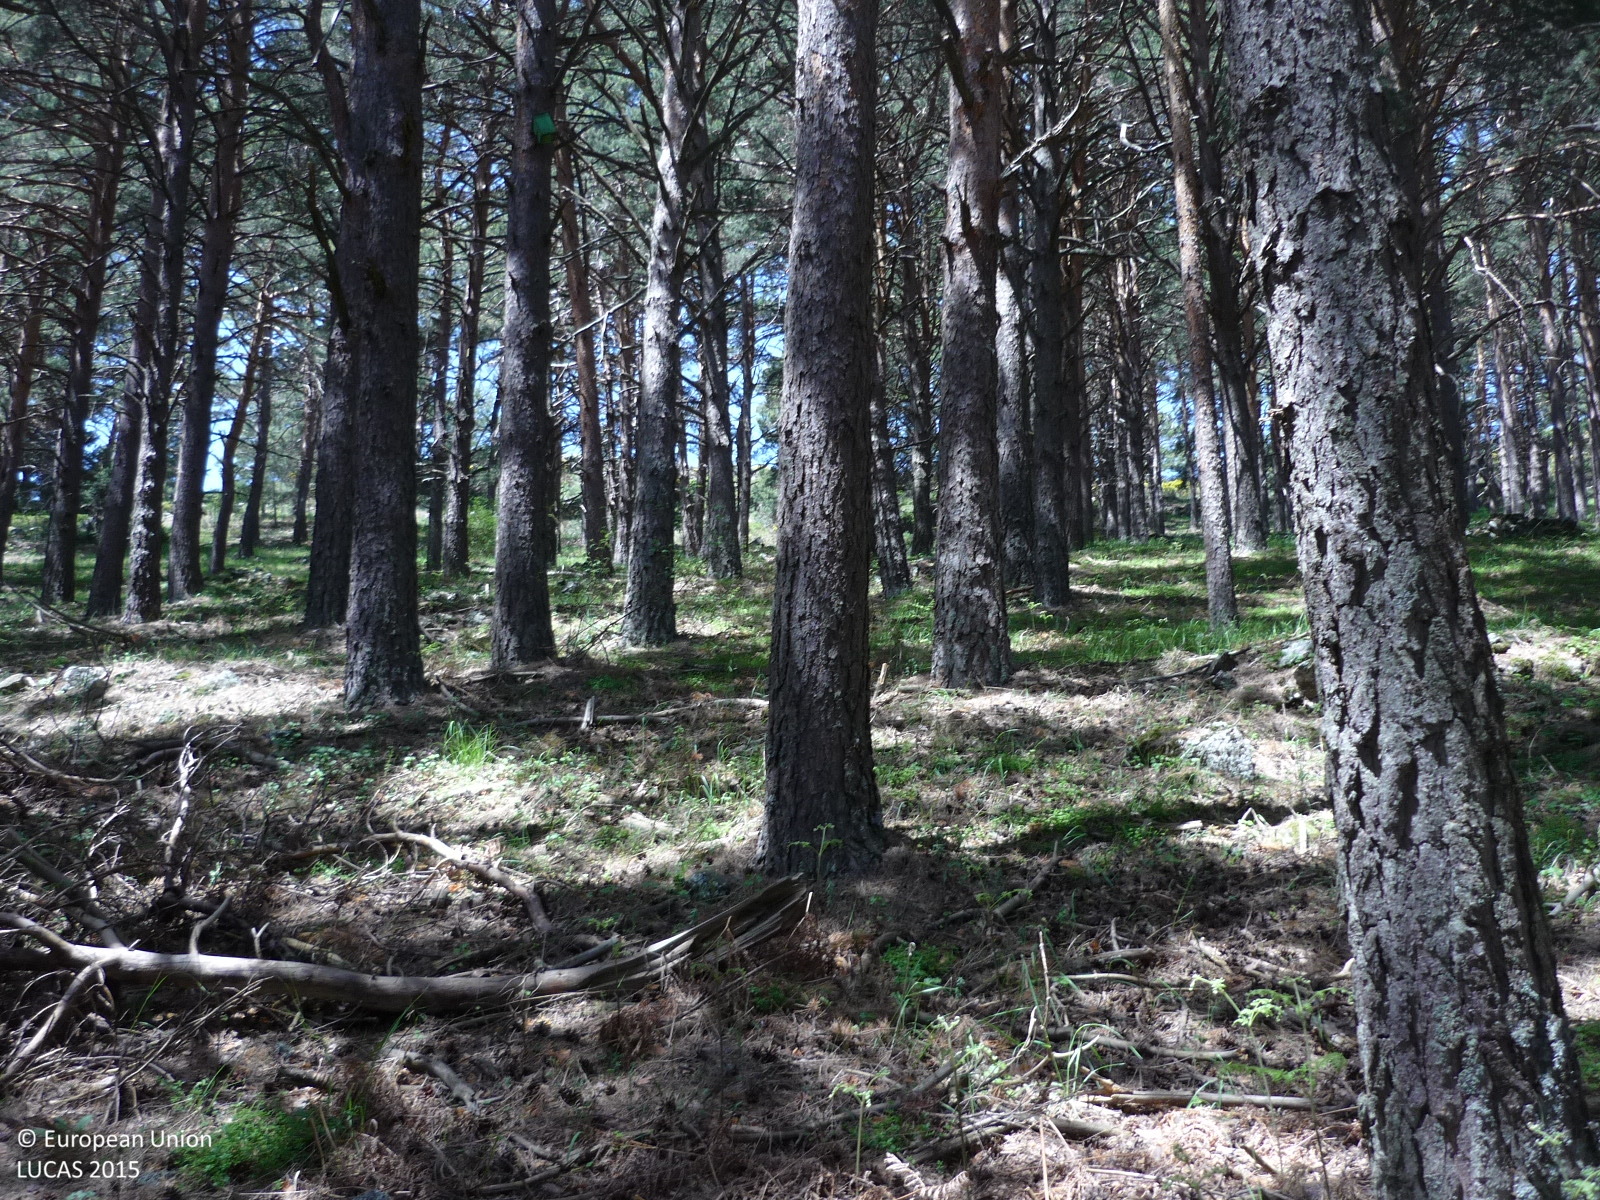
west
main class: Woodland
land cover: Pine dominated coniferous woodland
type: coniferous forest of the mediterranean region
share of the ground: > 75 %
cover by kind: coniferous forest trees 90 %, herbaceous plants 10 %
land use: Forestry
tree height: > 5 m
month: May
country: ES
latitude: 40.8066
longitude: -3.8063
